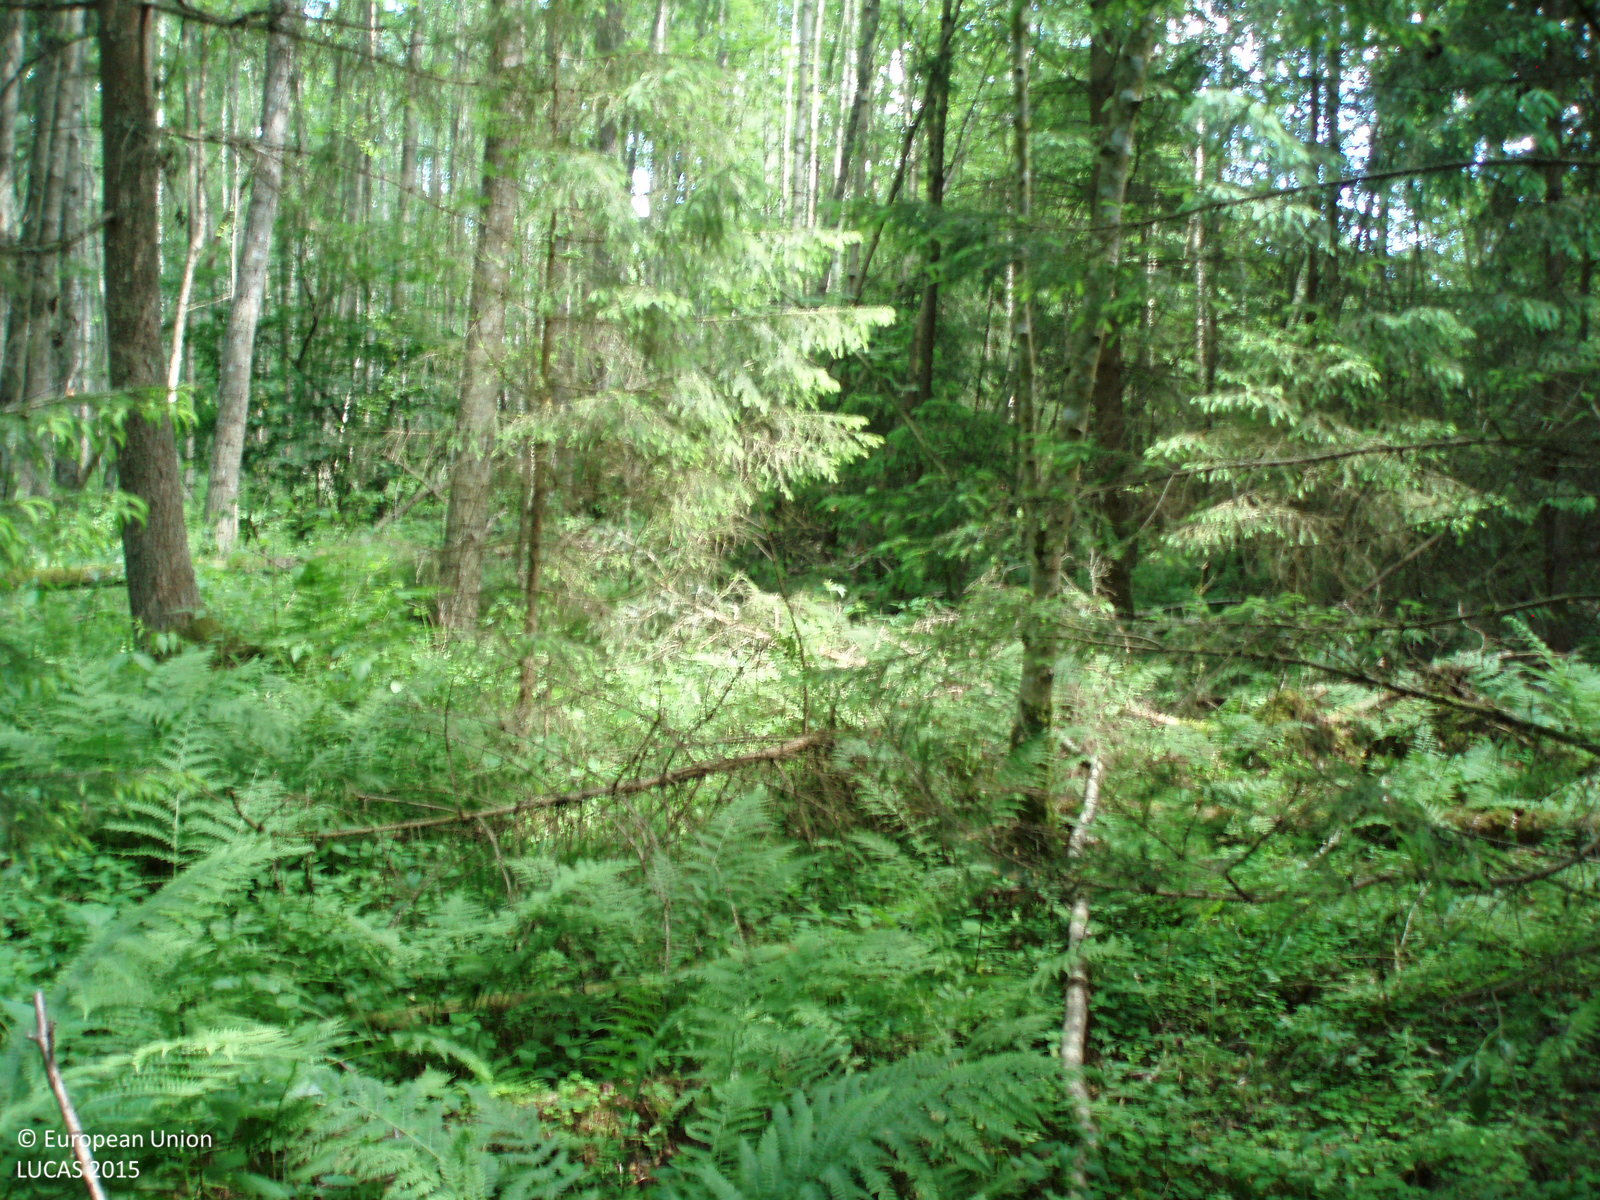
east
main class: Woodland
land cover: Spruce dominated mixed woodland
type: hemiboreal forest and nemoral coniferous forest and mixed broadleaved-coniferous forest
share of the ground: > 75 %
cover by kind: coniferous forest trees 50 %, broadleaved forest trees 40 %, herbaceous plants 10 %
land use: Forestry
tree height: > 5 m
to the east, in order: Spruce dominated mixed woodland; Spruce dominated coniferous woodland; Broadleaved woodland; Spruce dominated mixed woodland; Spruce dominated coniferous woodland; Broadleaved woodland; Spruce dominated mixed woodland
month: June
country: LT
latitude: 55.1923
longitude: 22.4870
